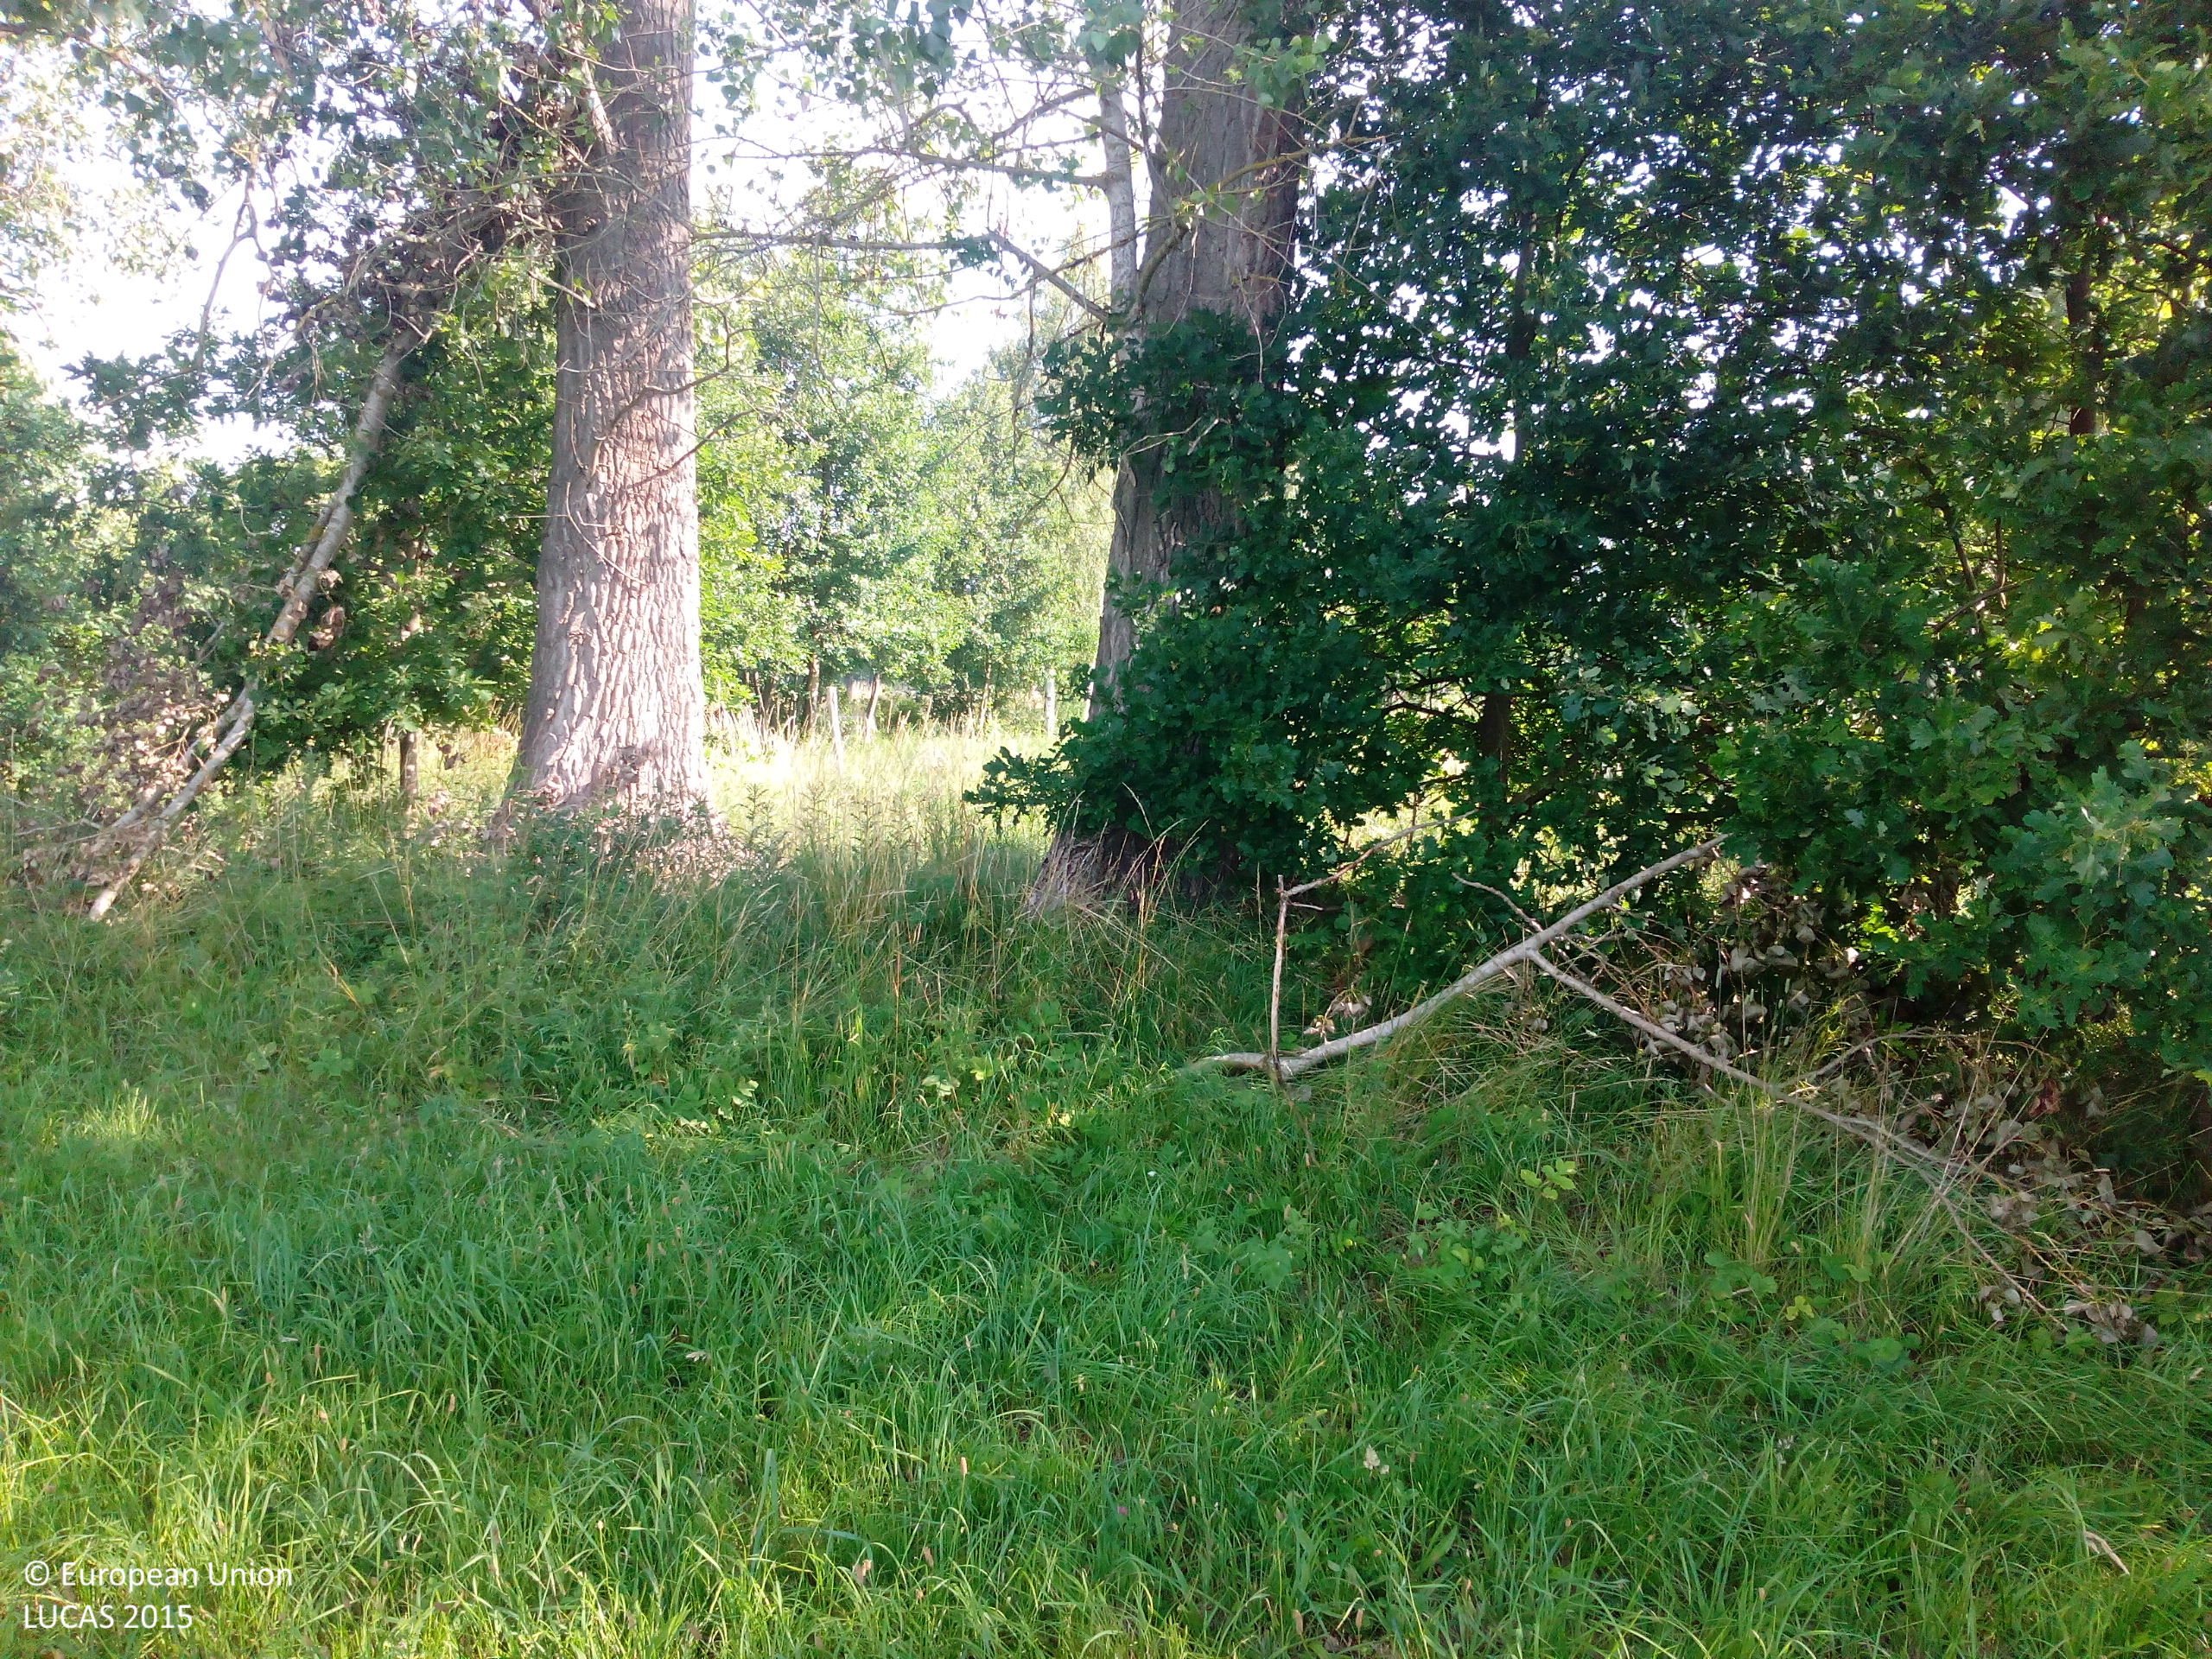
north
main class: Grassland
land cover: Grassland without tree/shrub cover
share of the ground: > 75 %
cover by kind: herbaceous plants 100 %
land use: Agriculture (excluding fallow land and kitchen gardens)
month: July
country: DE
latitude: 52.4979
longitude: 11.1338
